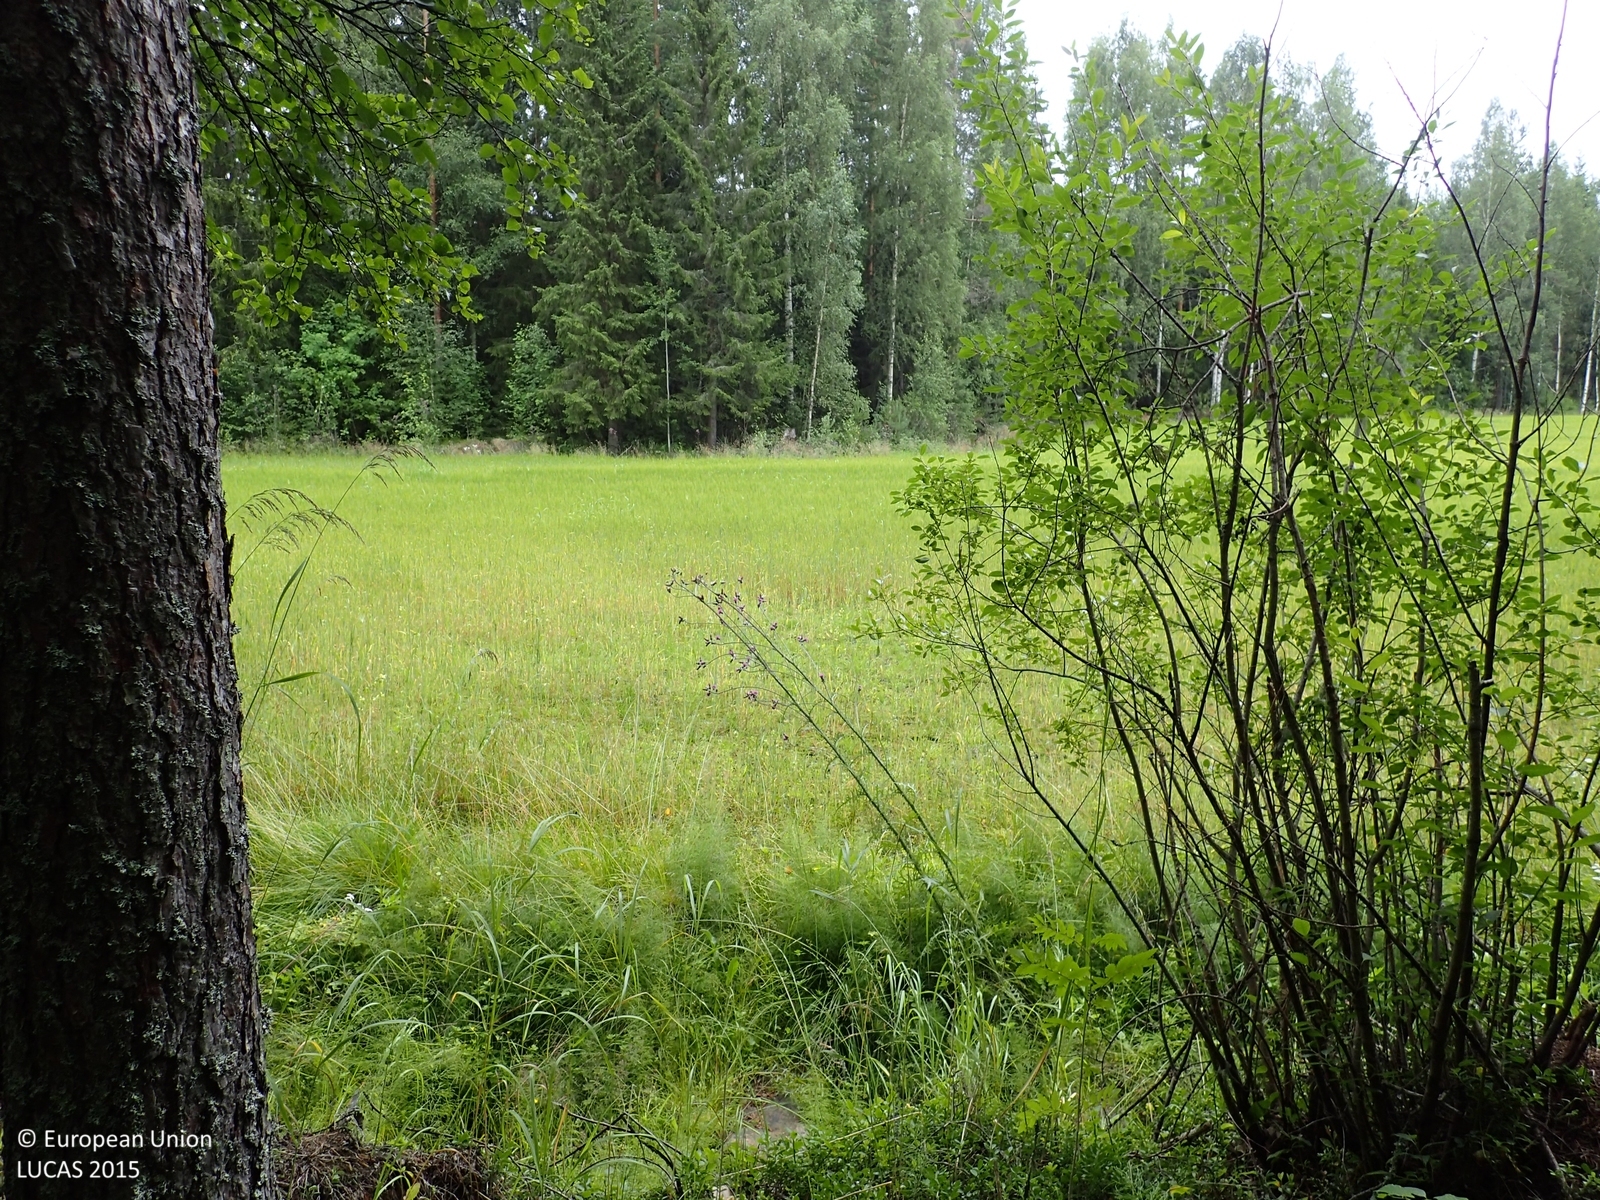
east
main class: Woodland
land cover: Other mixed woodland
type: boreal forest
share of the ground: > 75 %
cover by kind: coniferous forest trees 60 %, broadleaved forest trees 20 %, shrubs 20 %
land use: Forestry
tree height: > 5 m
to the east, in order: Other mixed woodland; Ditches and canals; Shruby margins; Barley; Shruby margins; Ditches and canals; Other mixed woodland; Ditches and canals; Pine dominated mixed woodland; Tracks; Pine dominated mixed woodland
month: August
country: FI
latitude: 62.9169
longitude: 21.9963
